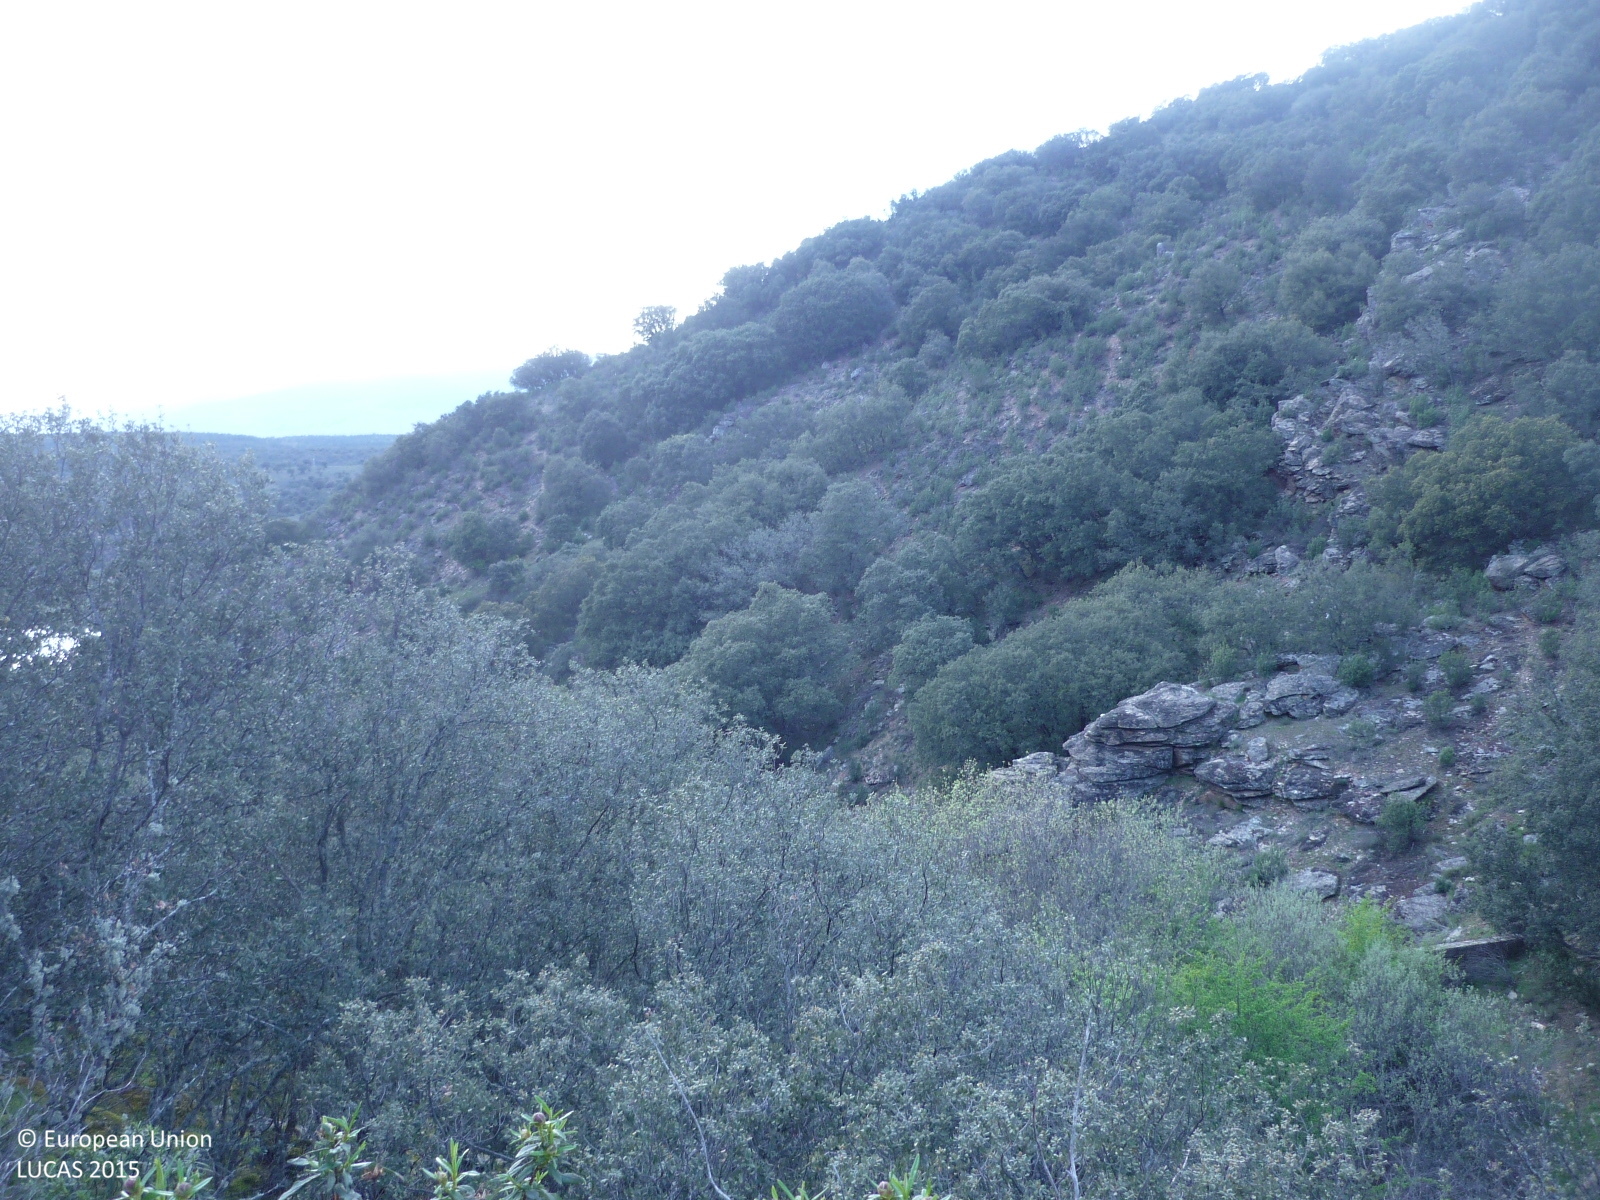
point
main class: Woodland
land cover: Broadleaved woodland
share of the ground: 50 - 75 %
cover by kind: broadleaved forest trees 50 %, herbaceous plants 30 %, shrubs 20 %
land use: Semi-natural and natural areas not in use
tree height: < 5 m
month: April
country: ES
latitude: 40.9877
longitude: -3.5575
